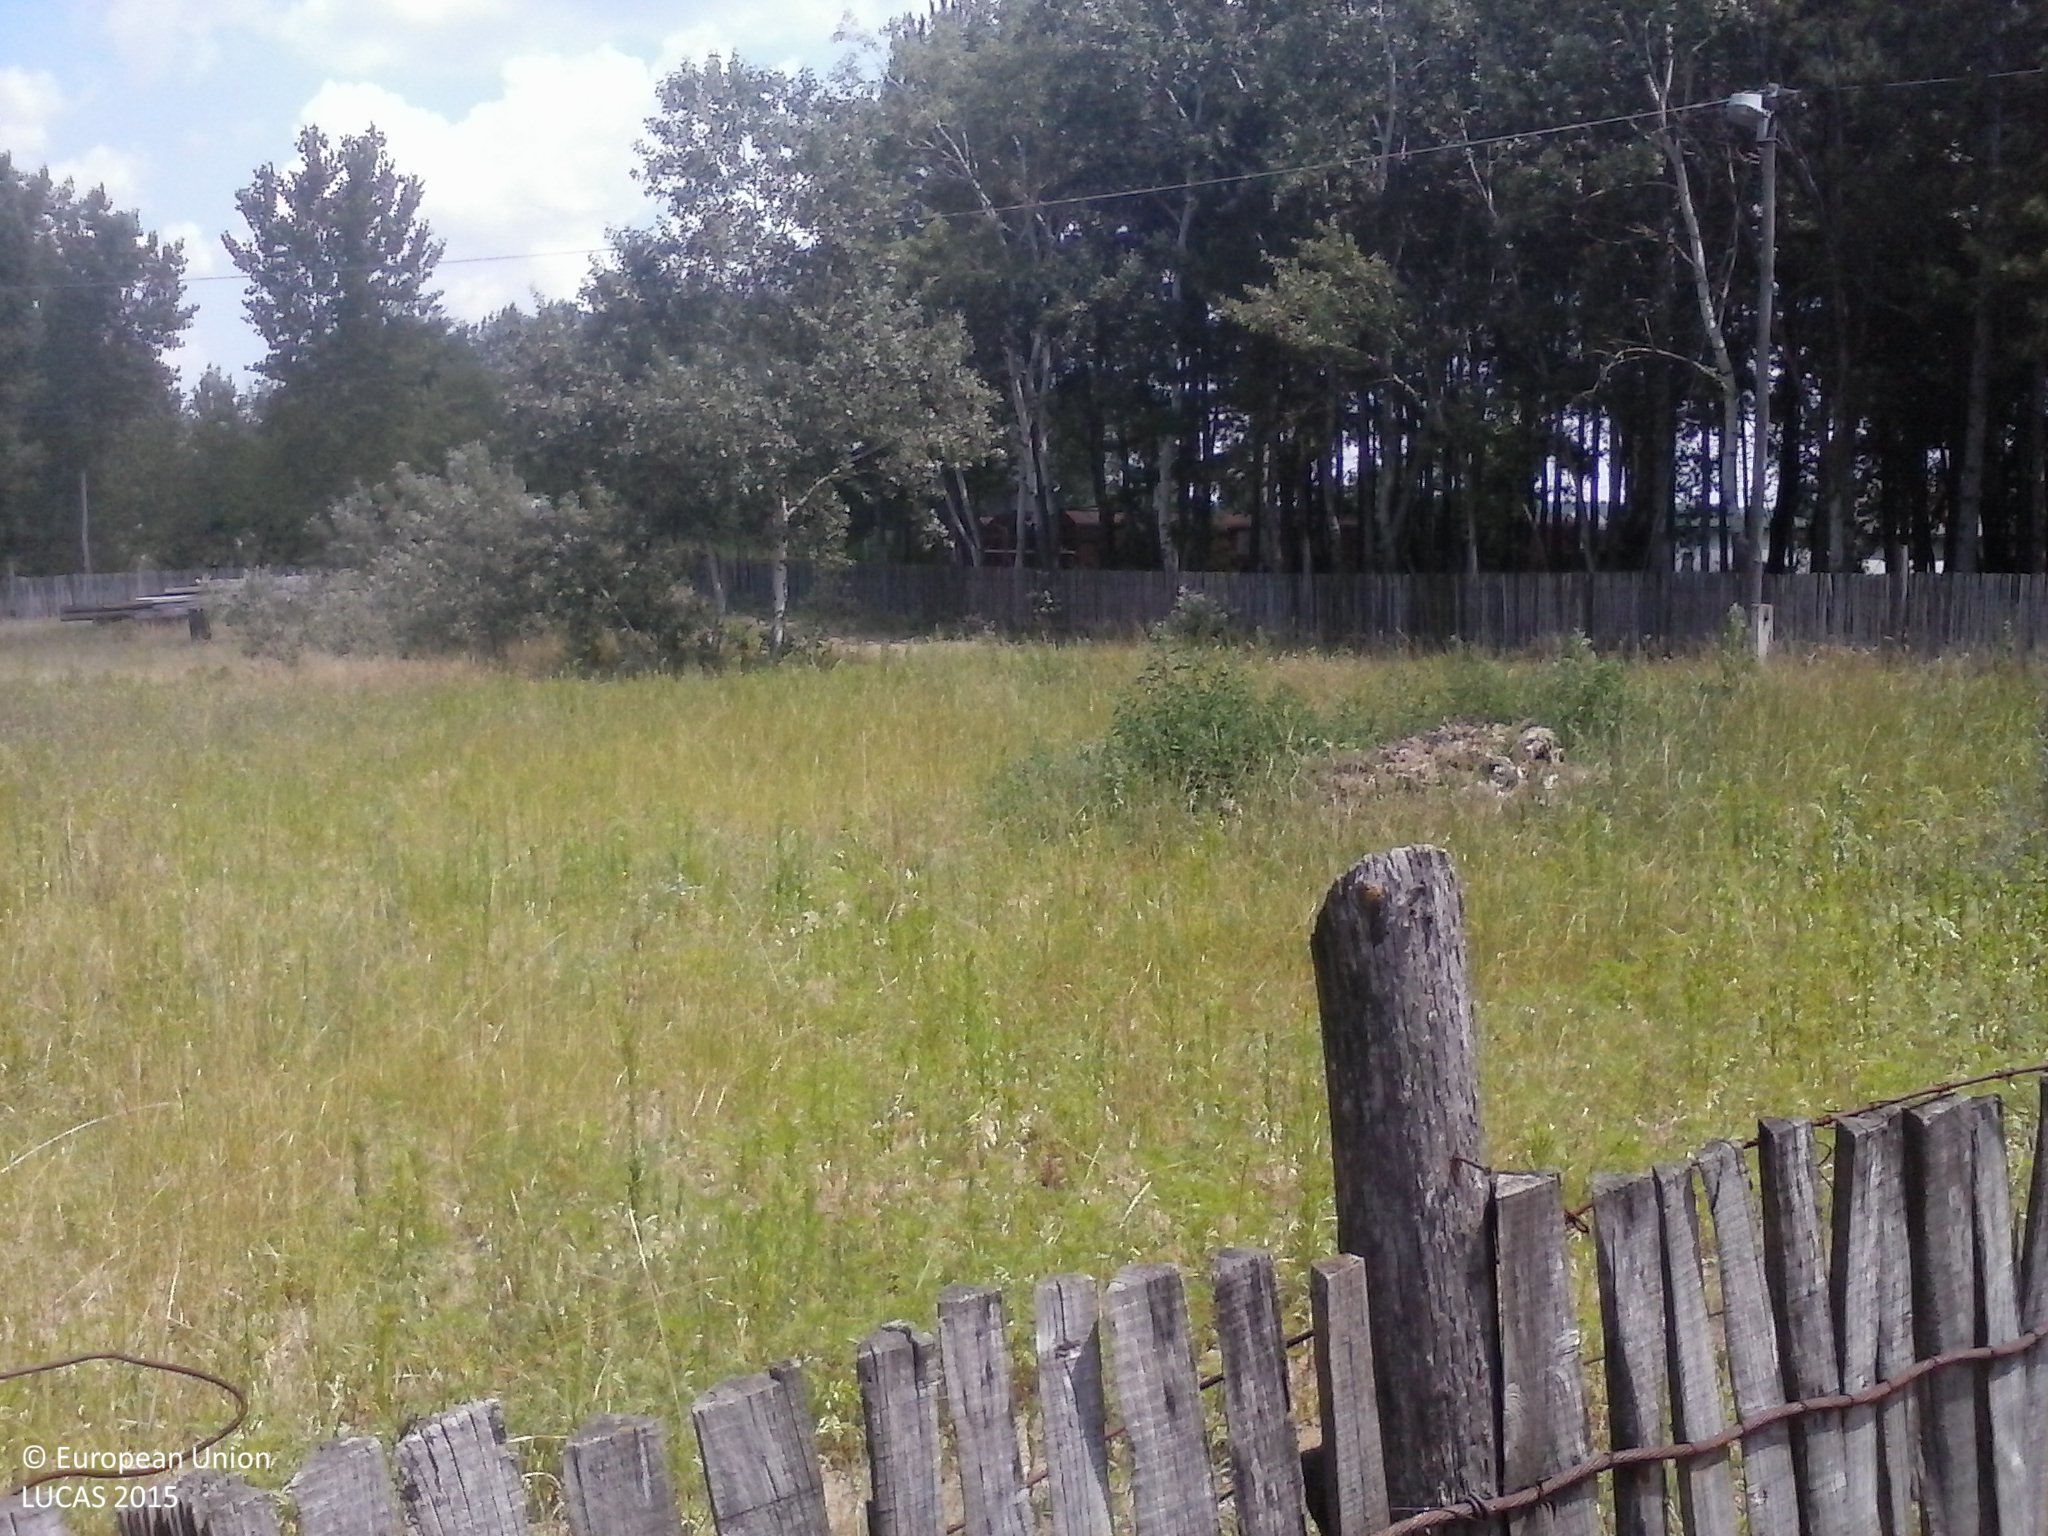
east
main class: Grassland
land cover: Grassland without tree/shrub cover
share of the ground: > 75 %
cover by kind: herbaceous plants 100 %
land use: Agriculture (excluding fallow land and kitchen gardens)
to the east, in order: Fences; Grassland without tree/shrub cover; Grassland with sparse tree/shrub cover; Electric lines; Fences; Grass margins; Tracks; Pine dominated mixed woodland; Artificial constructions in urban areas
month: July
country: HU
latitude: 46.3587
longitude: 19.5437
